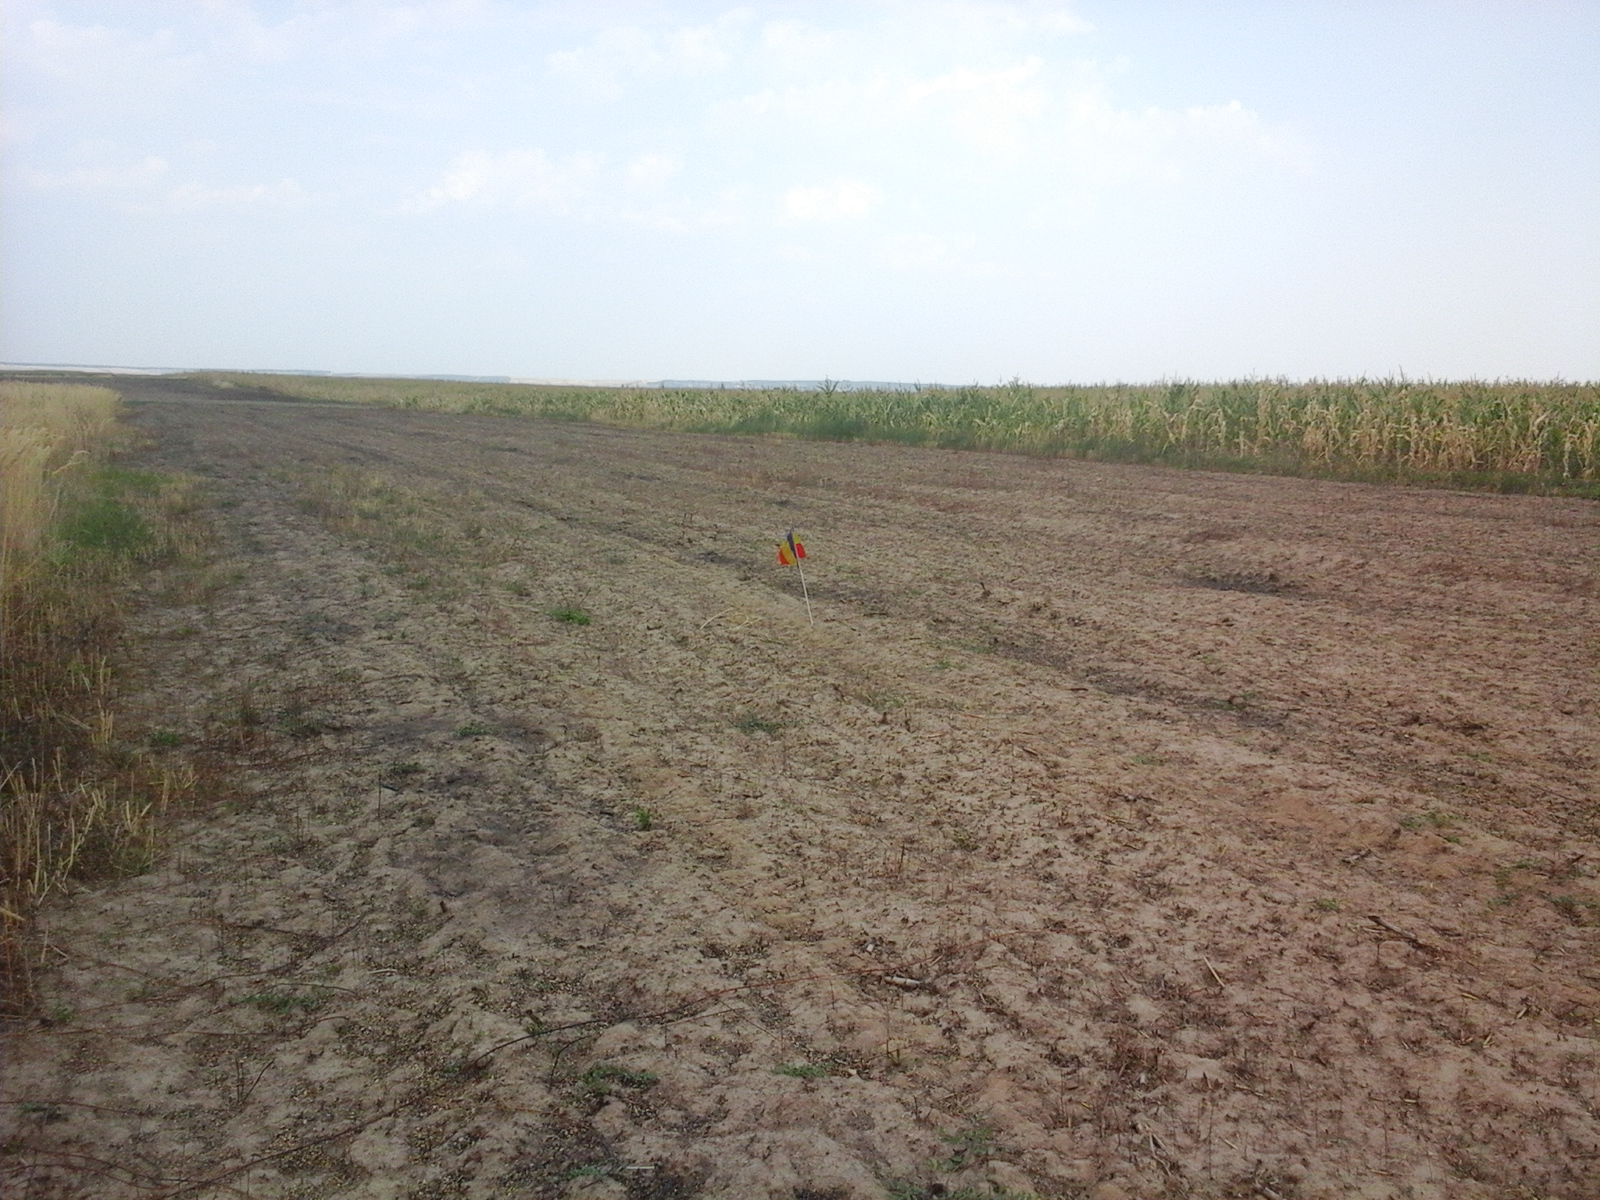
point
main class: Cropland
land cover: Durum wheat
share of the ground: < 10 %
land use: Agriculture (excluding fallow land and kitchen gardens)
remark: Burnt area
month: August
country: RO
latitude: 44.4014
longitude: 22.7348
